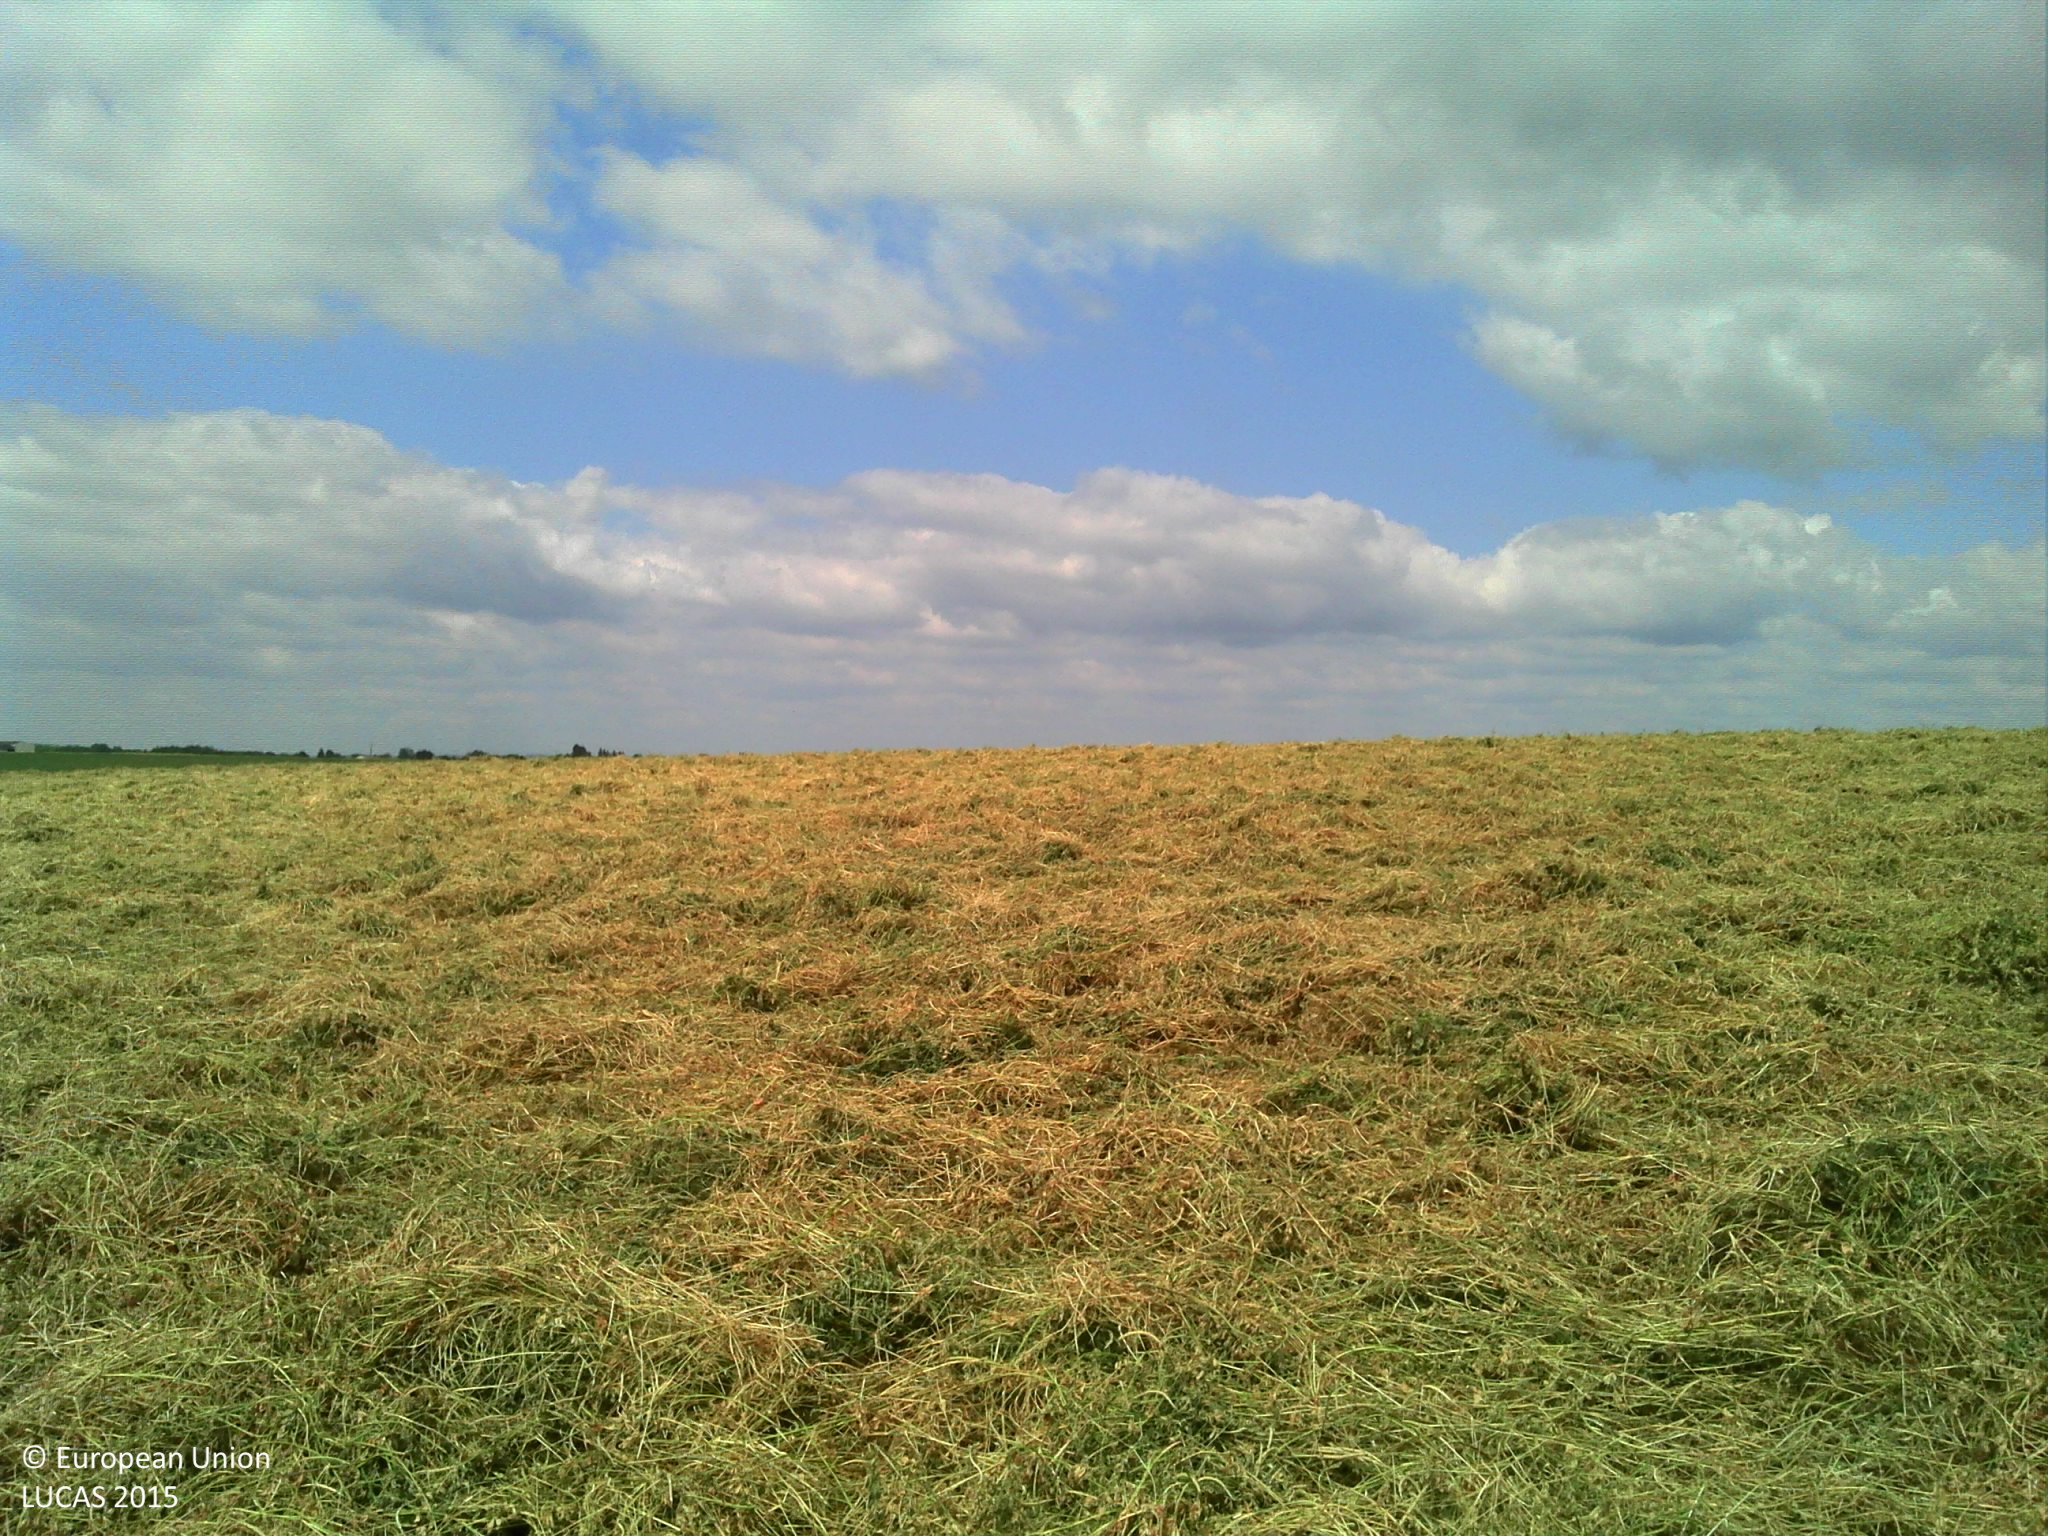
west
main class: Cropland
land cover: Lucerne
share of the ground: > 75 %
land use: Agriculture (excluding fallow land and kitchen gardens)
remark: Harvested field
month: May
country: FR
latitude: 47.3986
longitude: 5.2174
